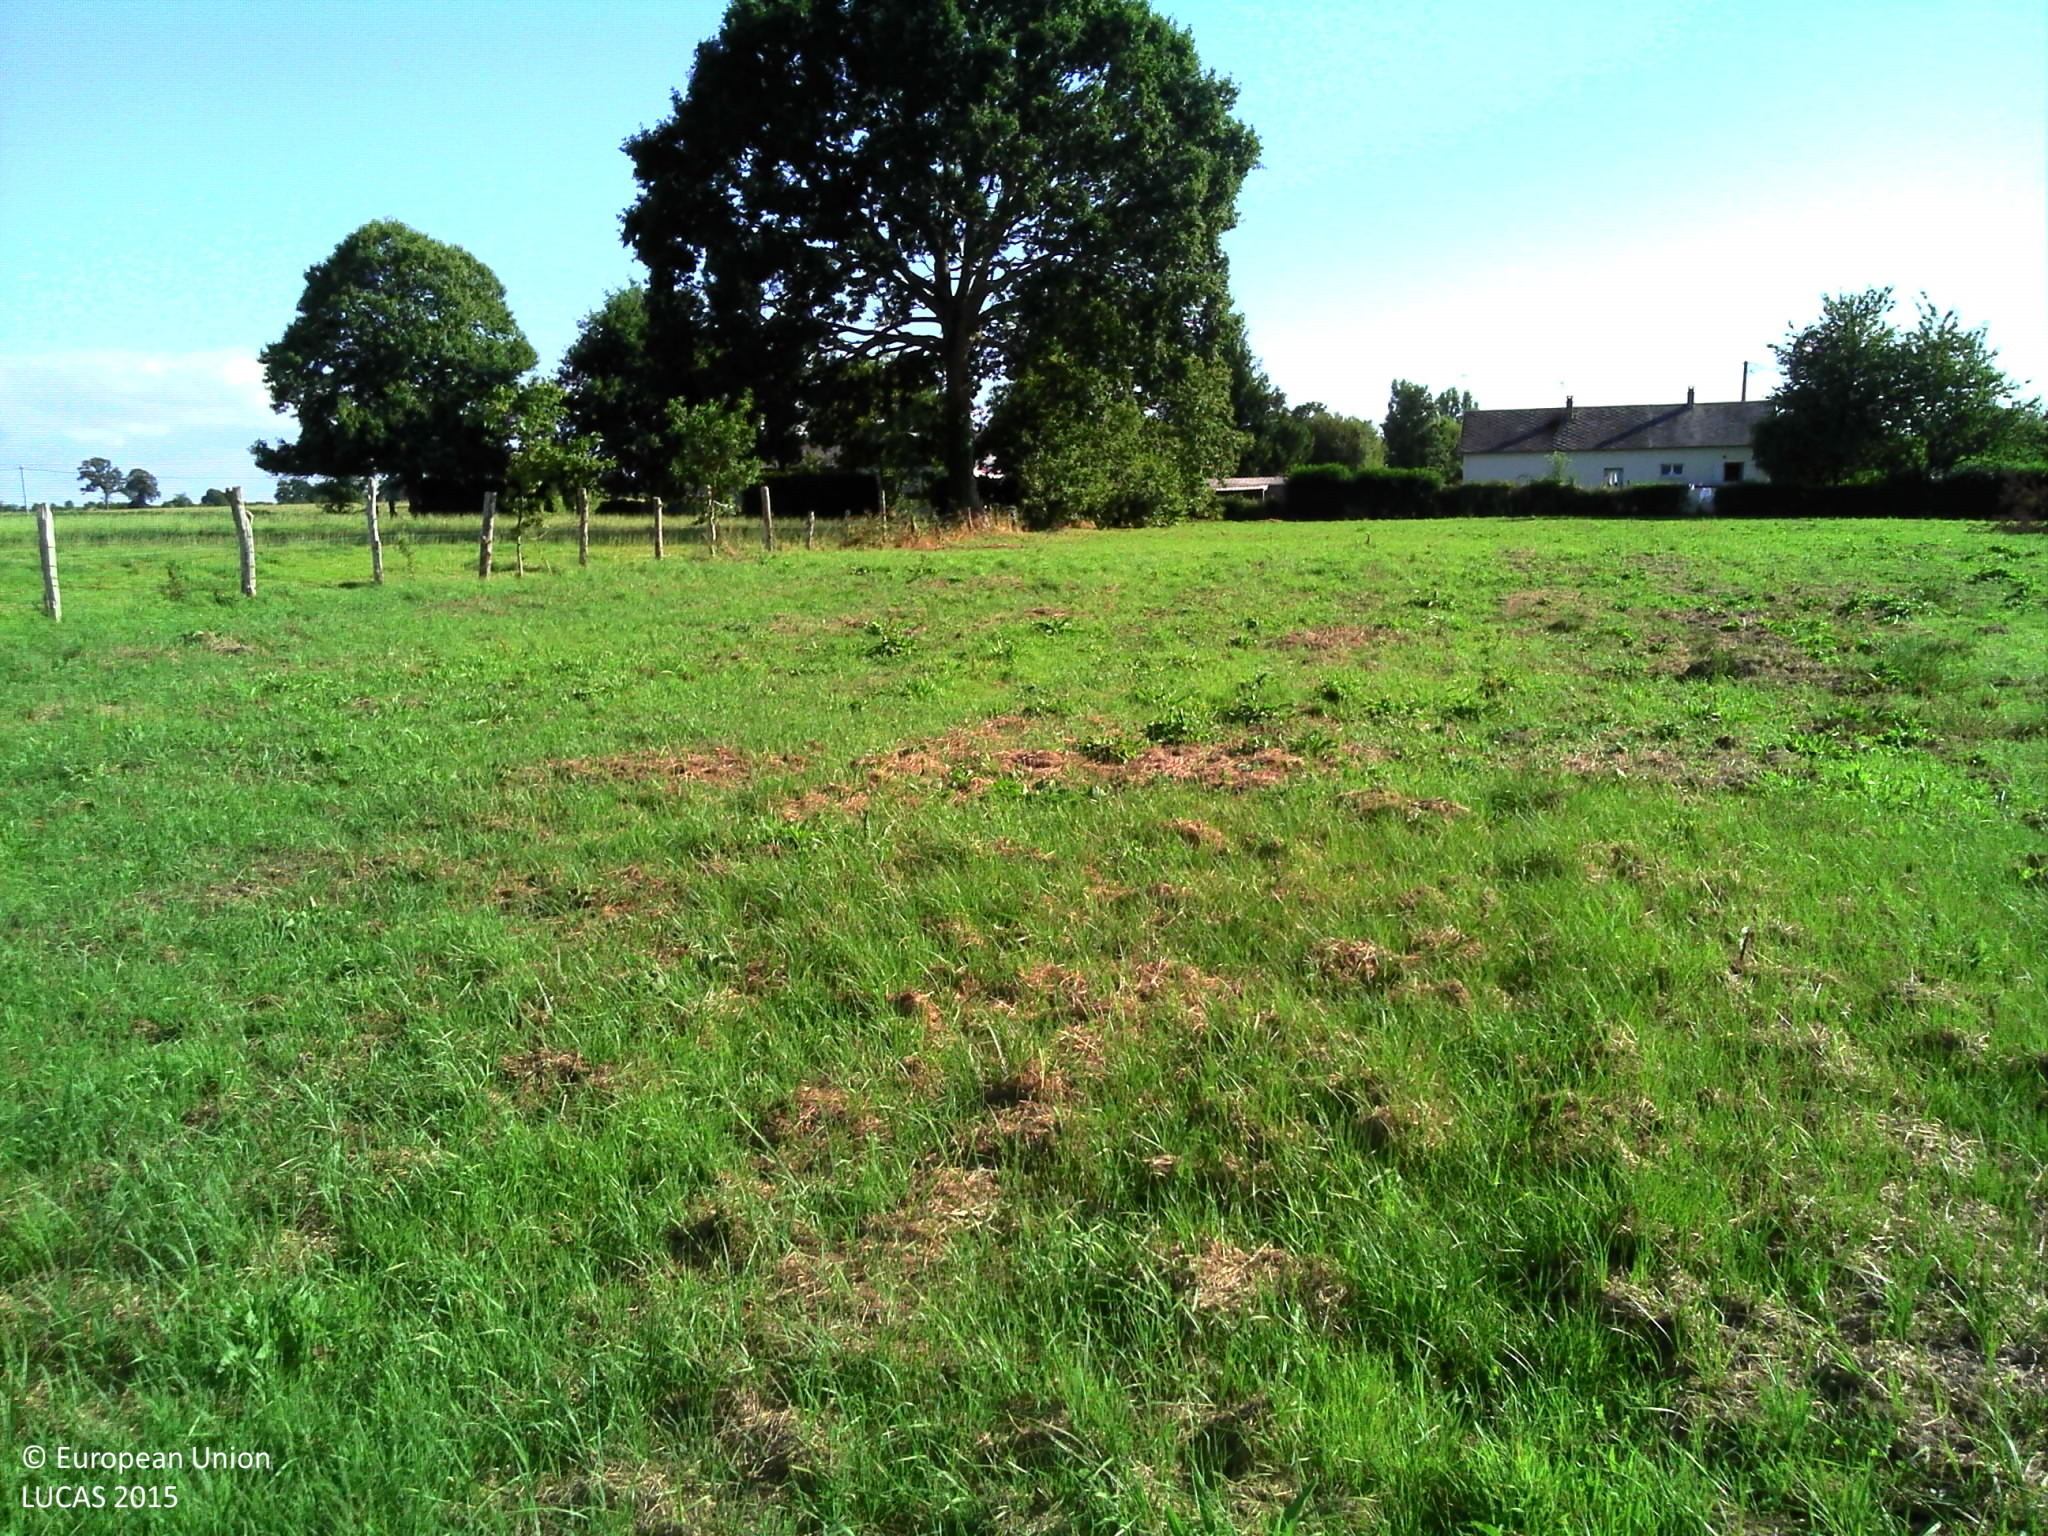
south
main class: Grassland
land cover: Grassland without tree/shrub cover
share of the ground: > 75 %
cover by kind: herbaceous plants 100 %
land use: Agriculture (excluding fallow land and kitchen gardens)
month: August
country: FR
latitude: 48.6196
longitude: -1.3181
